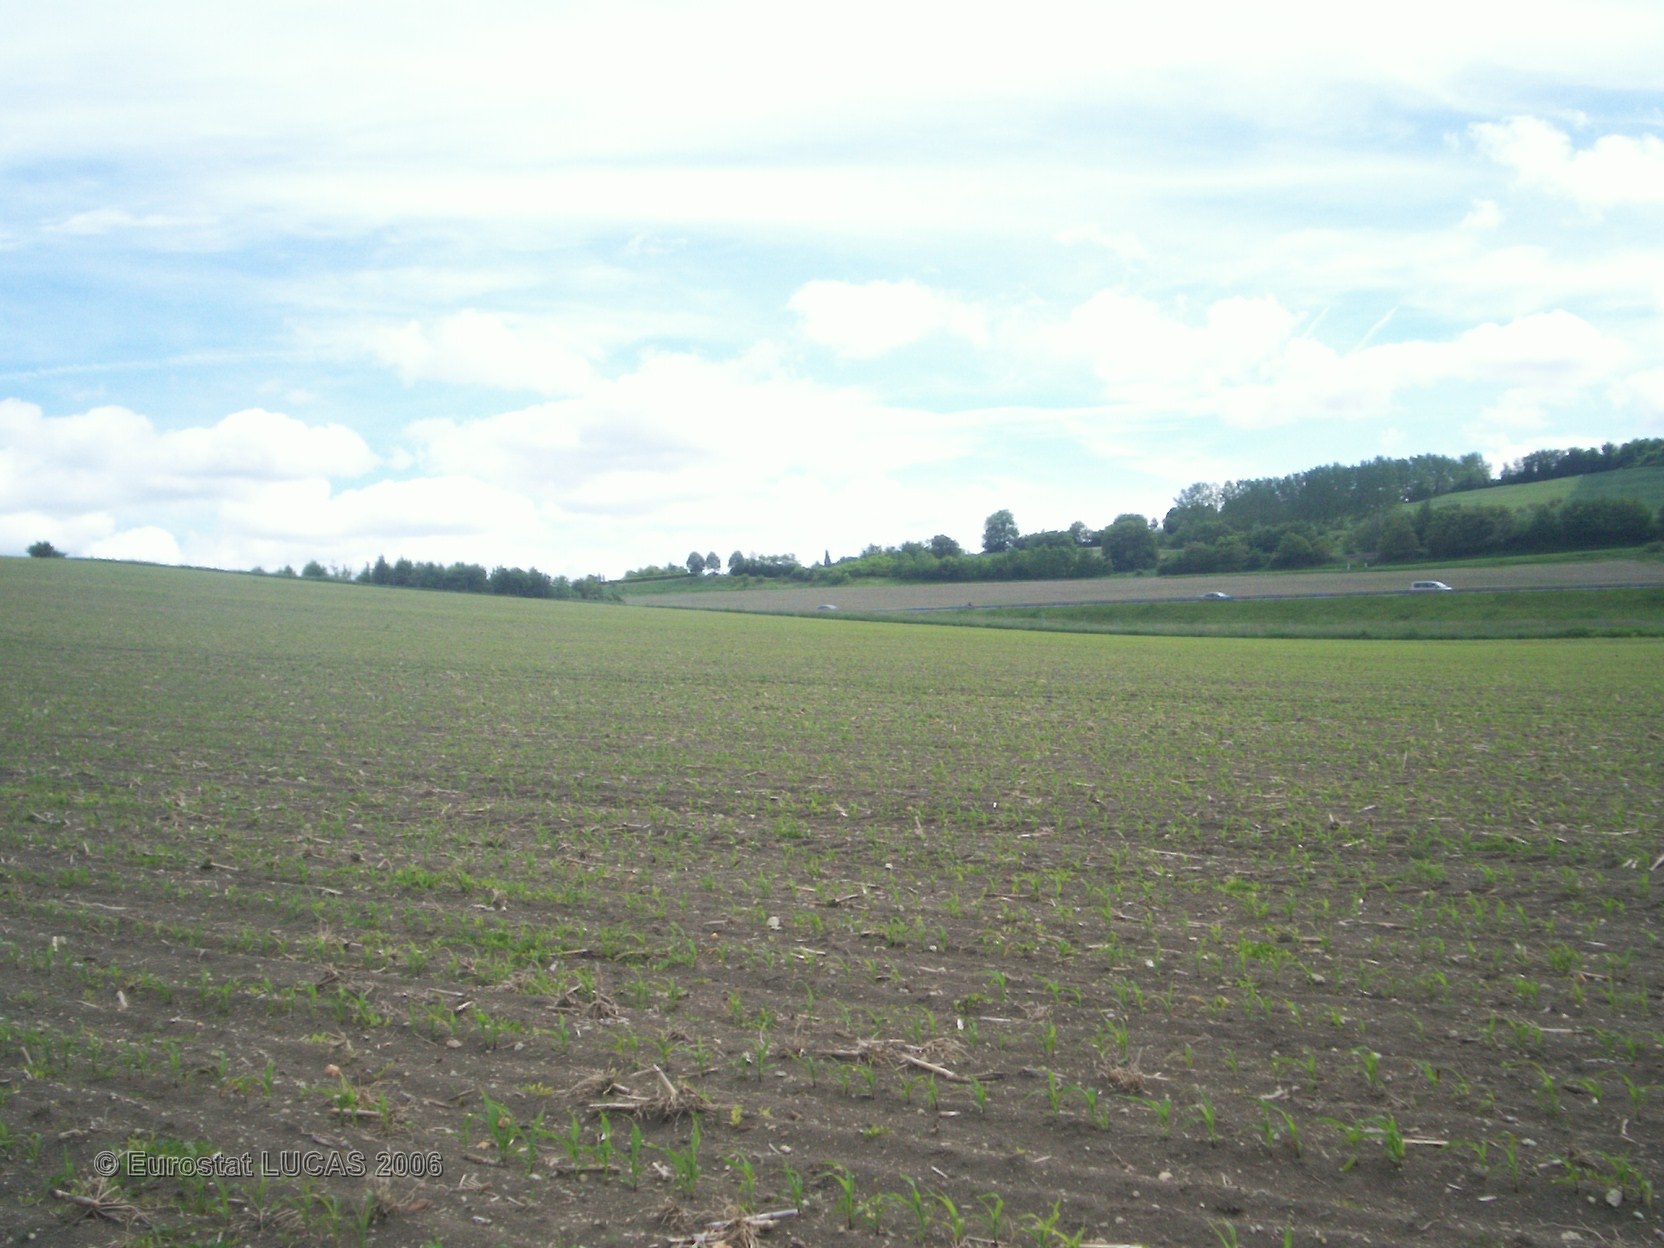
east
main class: Cropland
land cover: Maize
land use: Agriculture (excluding fallow land and kitchen gardens)
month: May
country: FR
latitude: 46.1838
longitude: 3.1192
